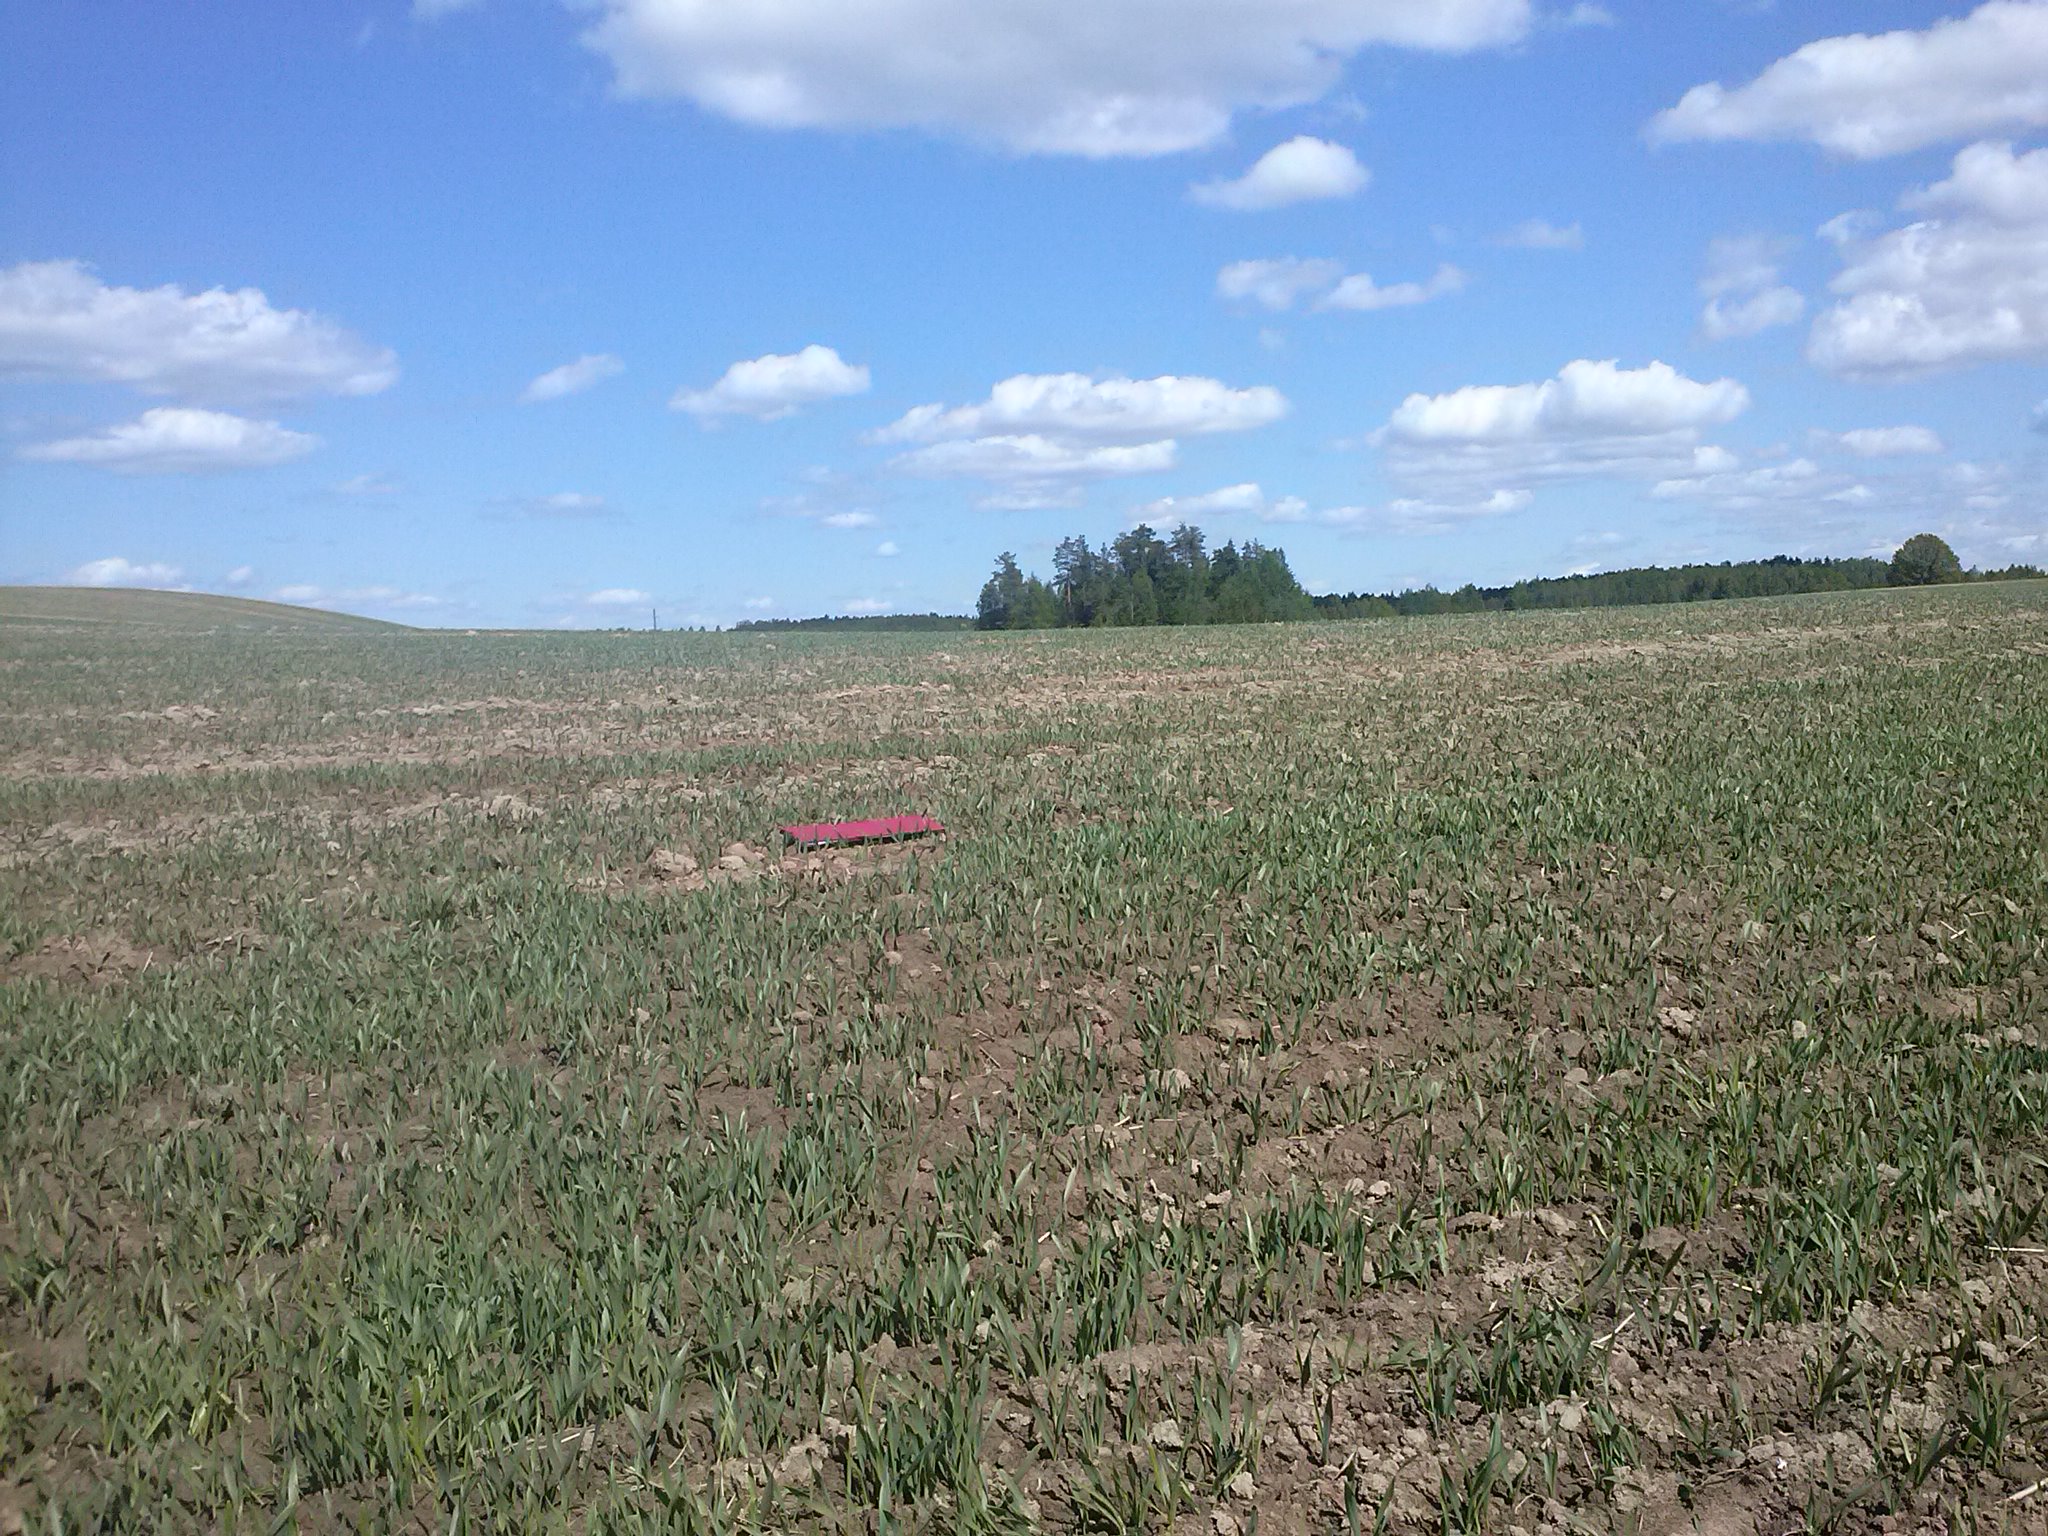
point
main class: Cropland
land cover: Rye
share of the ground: 10 - 25 %
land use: Agriculture (excluding fallow land and kitchen gardens)
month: May
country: LV
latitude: 56.1188
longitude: 27.6037
